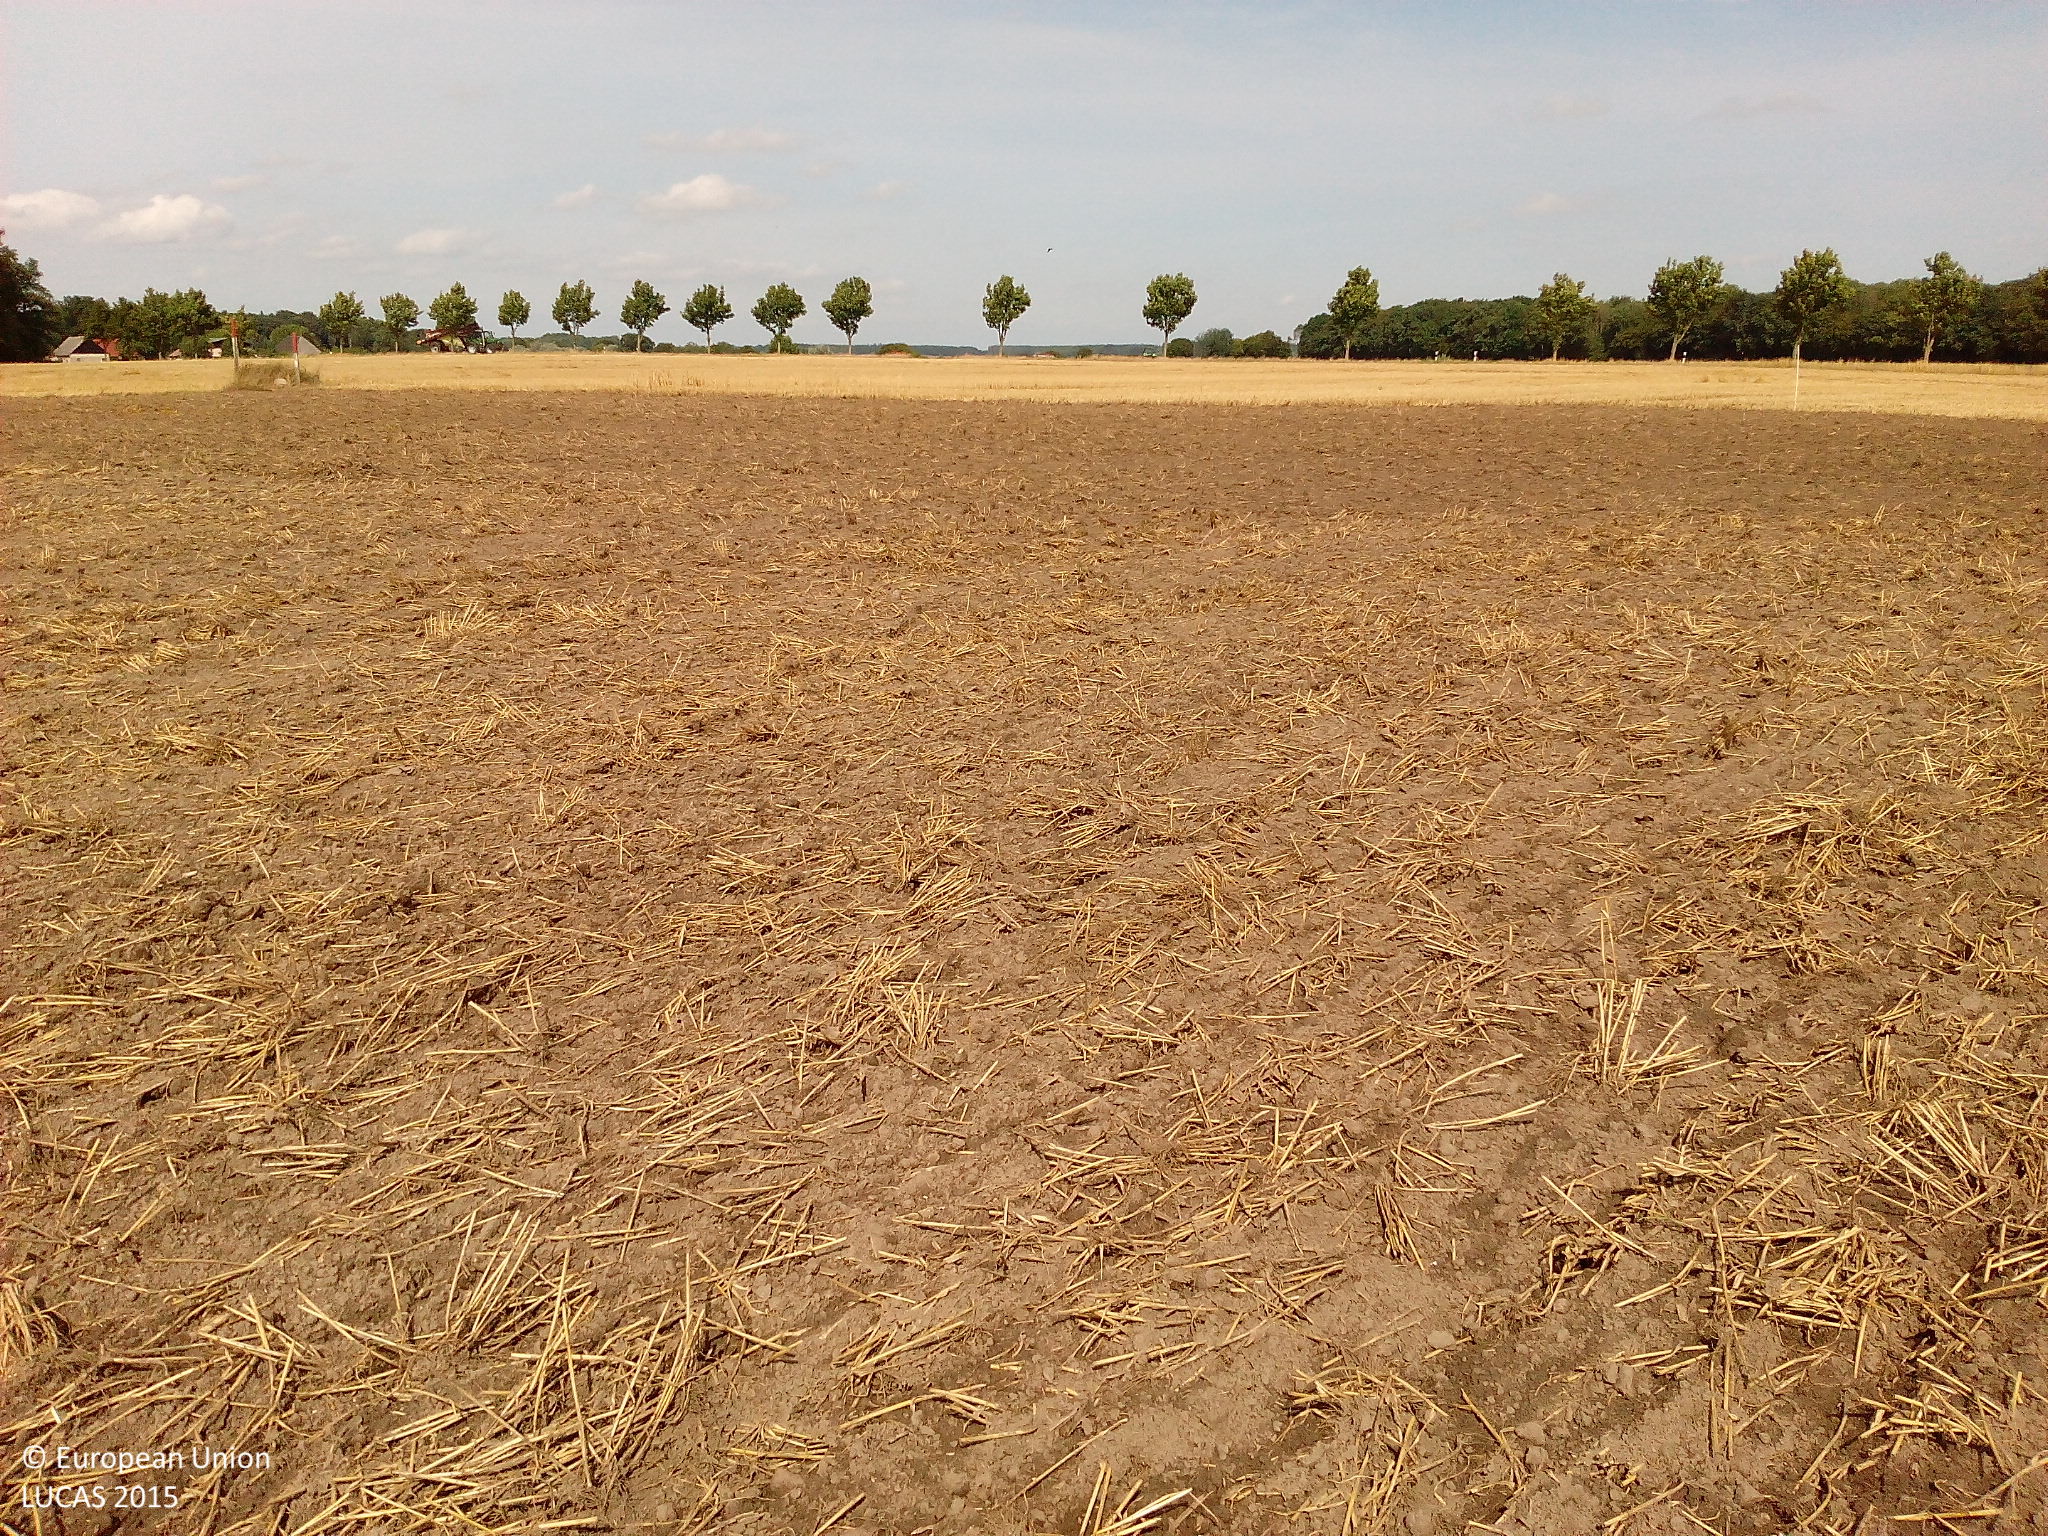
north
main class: Cropland
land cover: Common wheat
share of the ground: < 10 %
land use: Agriculture (excluding fallow land and kitchen gardens)
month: August
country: DE
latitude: 53.9487
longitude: 12.6351
